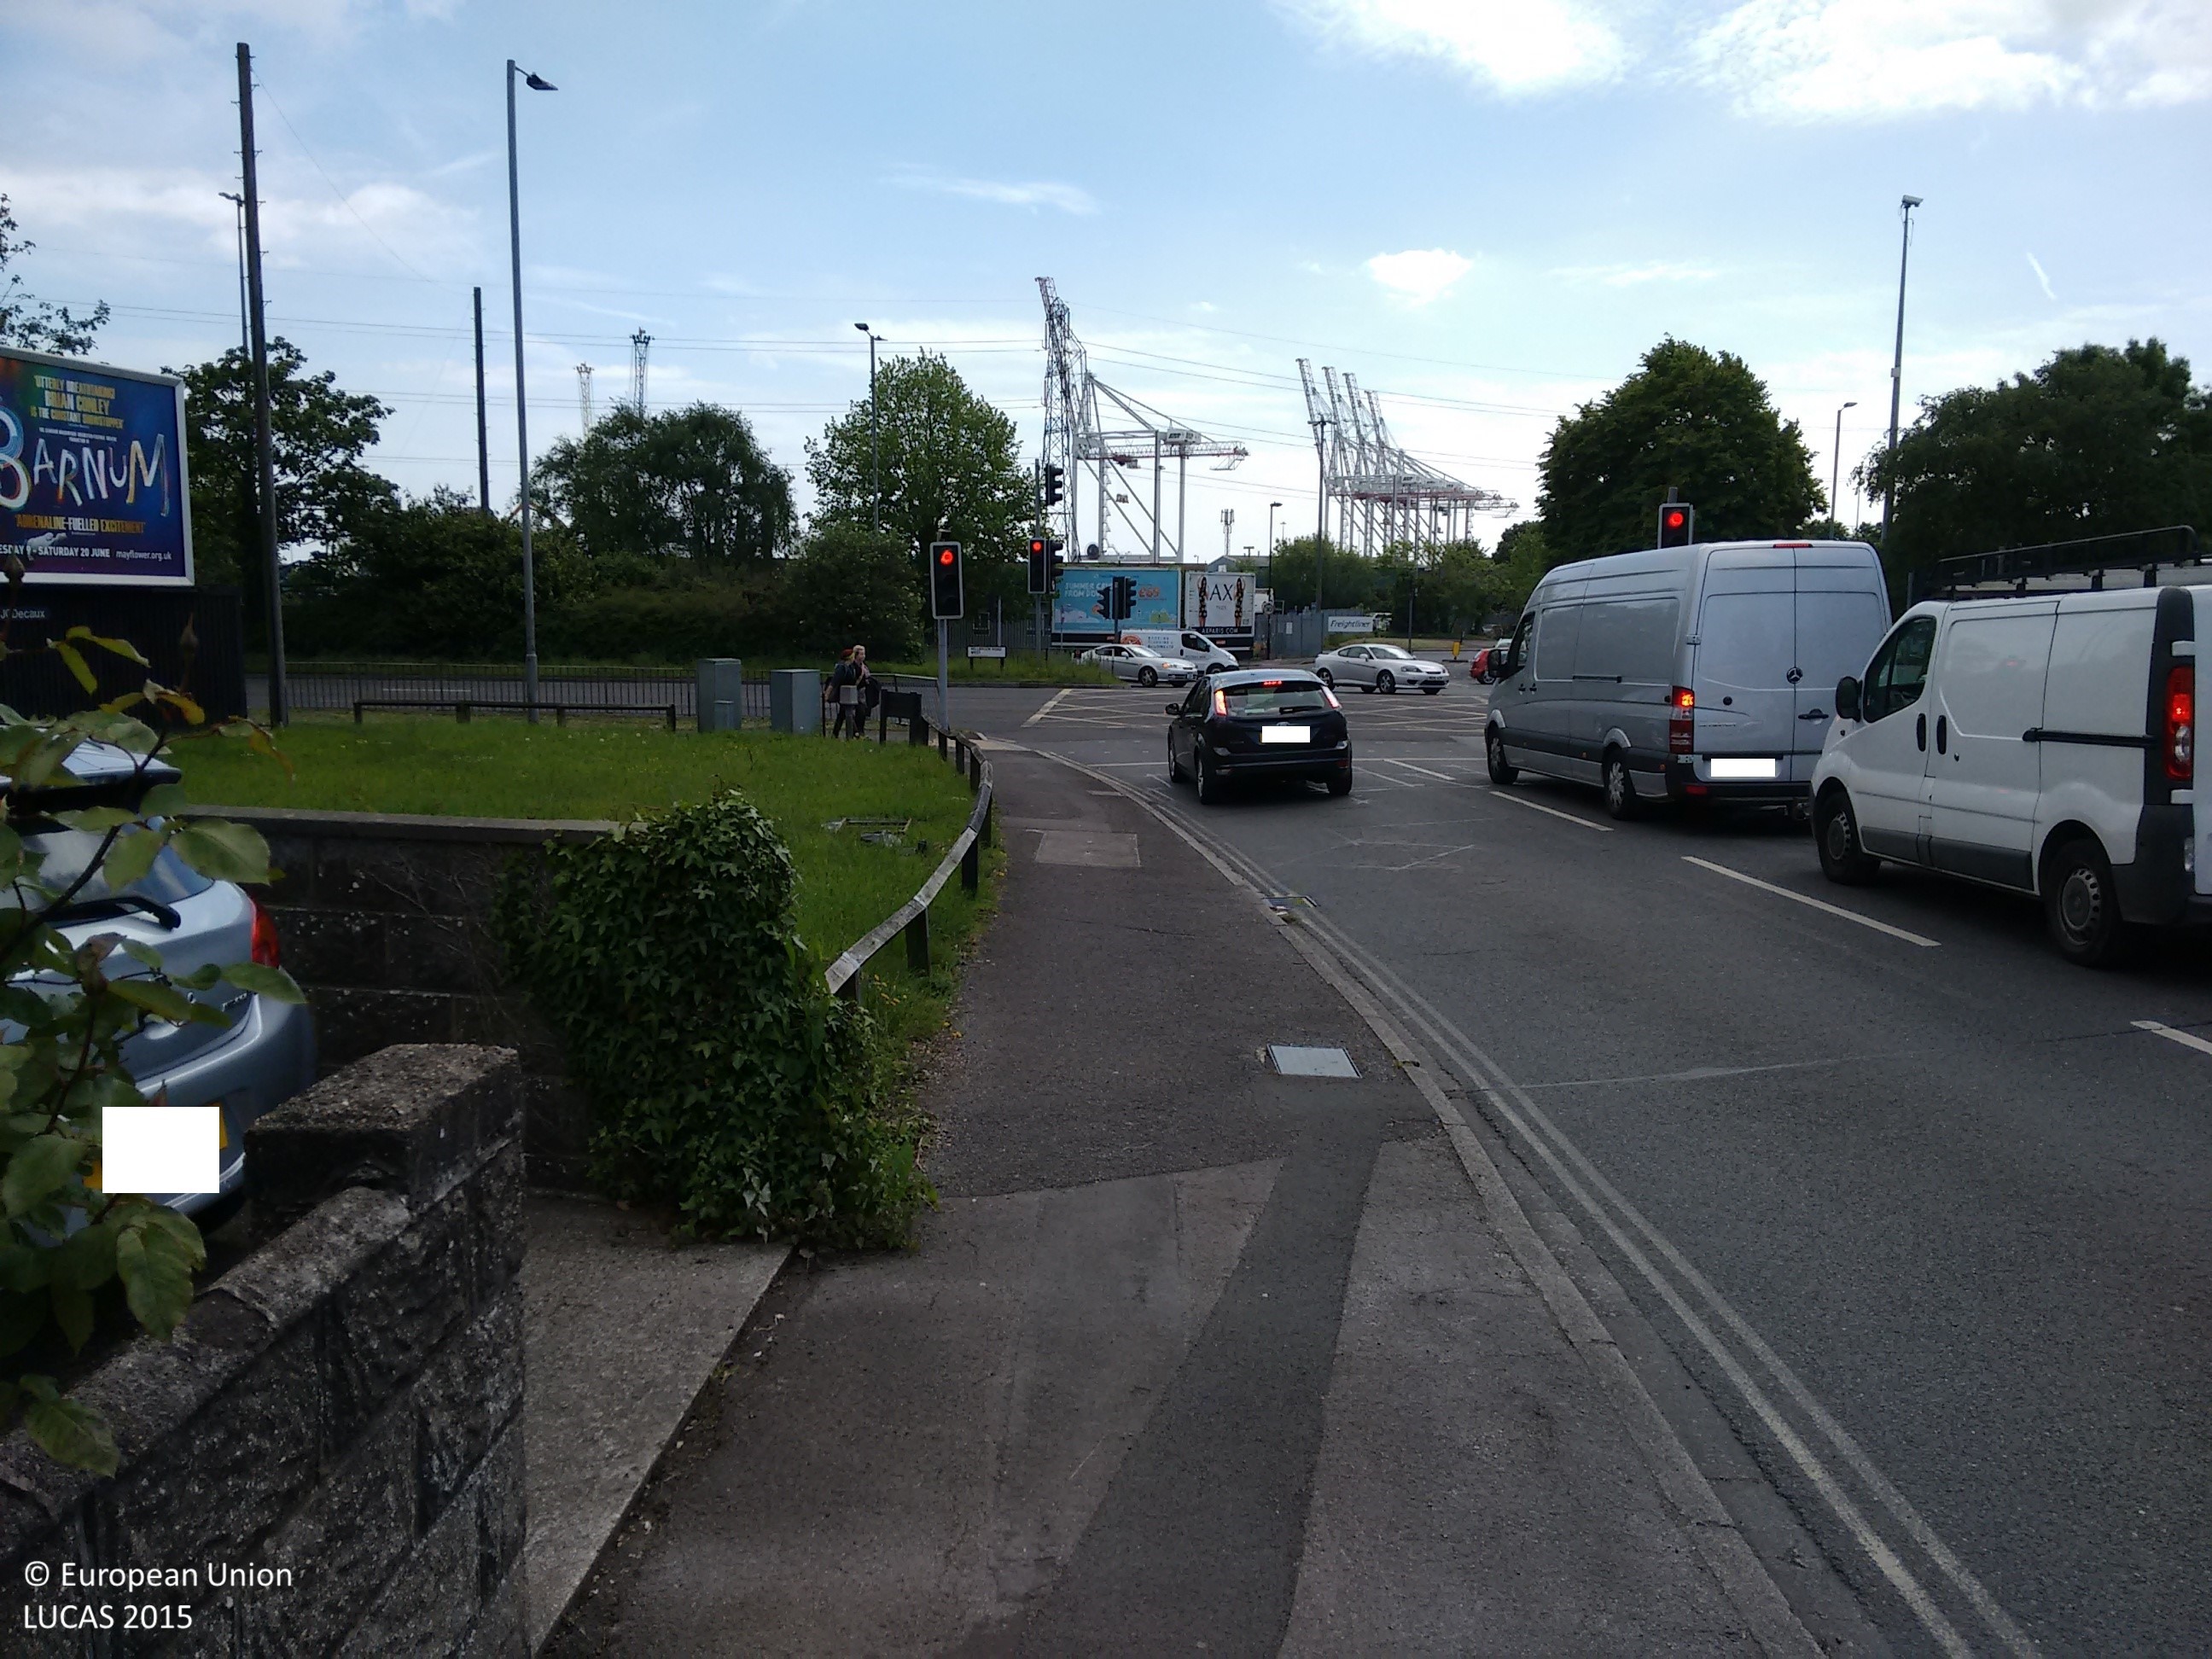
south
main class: Grassland
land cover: Grassland without tree/shrub cover
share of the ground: 50 - 75 %
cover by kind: herbaceous plants 95 %, shrubs 5 %
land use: Residential
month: May
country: GB
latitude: 50.9138
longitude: -1.4431
